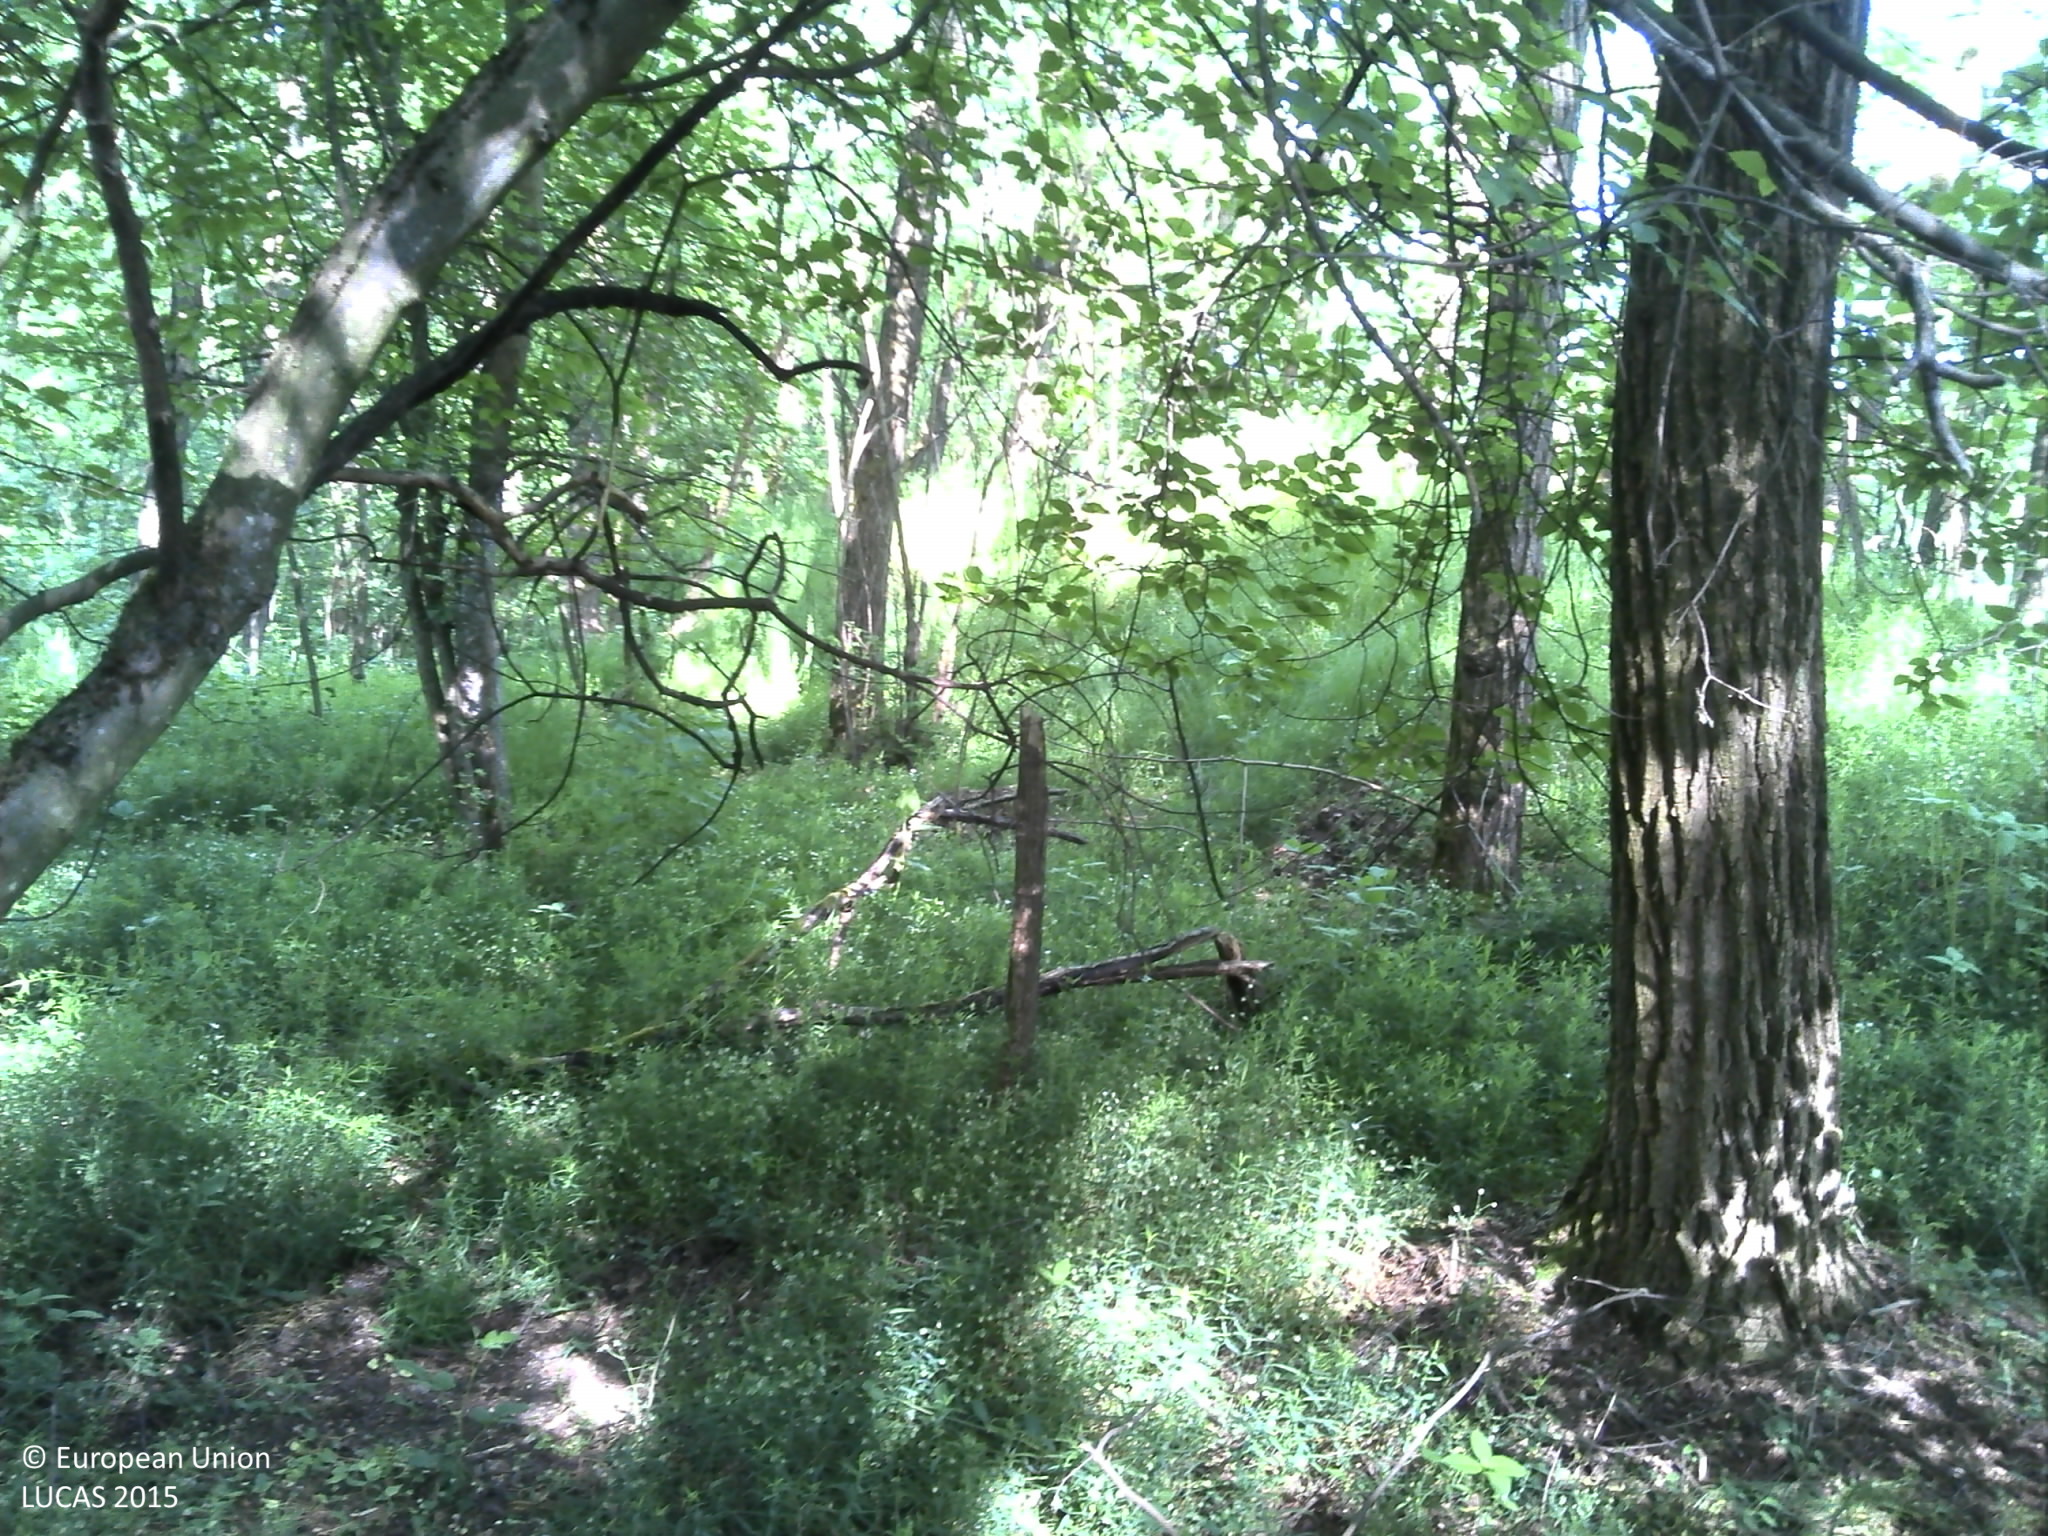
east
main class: Woodland
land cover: Broadleaved woodland
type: acidophilous oak and oak-birch forest
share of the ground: > 75 %
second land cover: Spontaneously vegetated surfaces
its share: 10 - 25 %
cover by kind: broadleaved forest trees 80 %, herbaceous plants 10 %, lichens and mosses 10 %
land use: Forestry
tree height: < 5 m
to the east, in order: Broadleaved woodland; Spontaneously vegetated surfaces; Grass margins; Common wheat; Electric lines; Common wheat
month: May
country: HR
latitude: 45.1920
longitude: 18.1110
